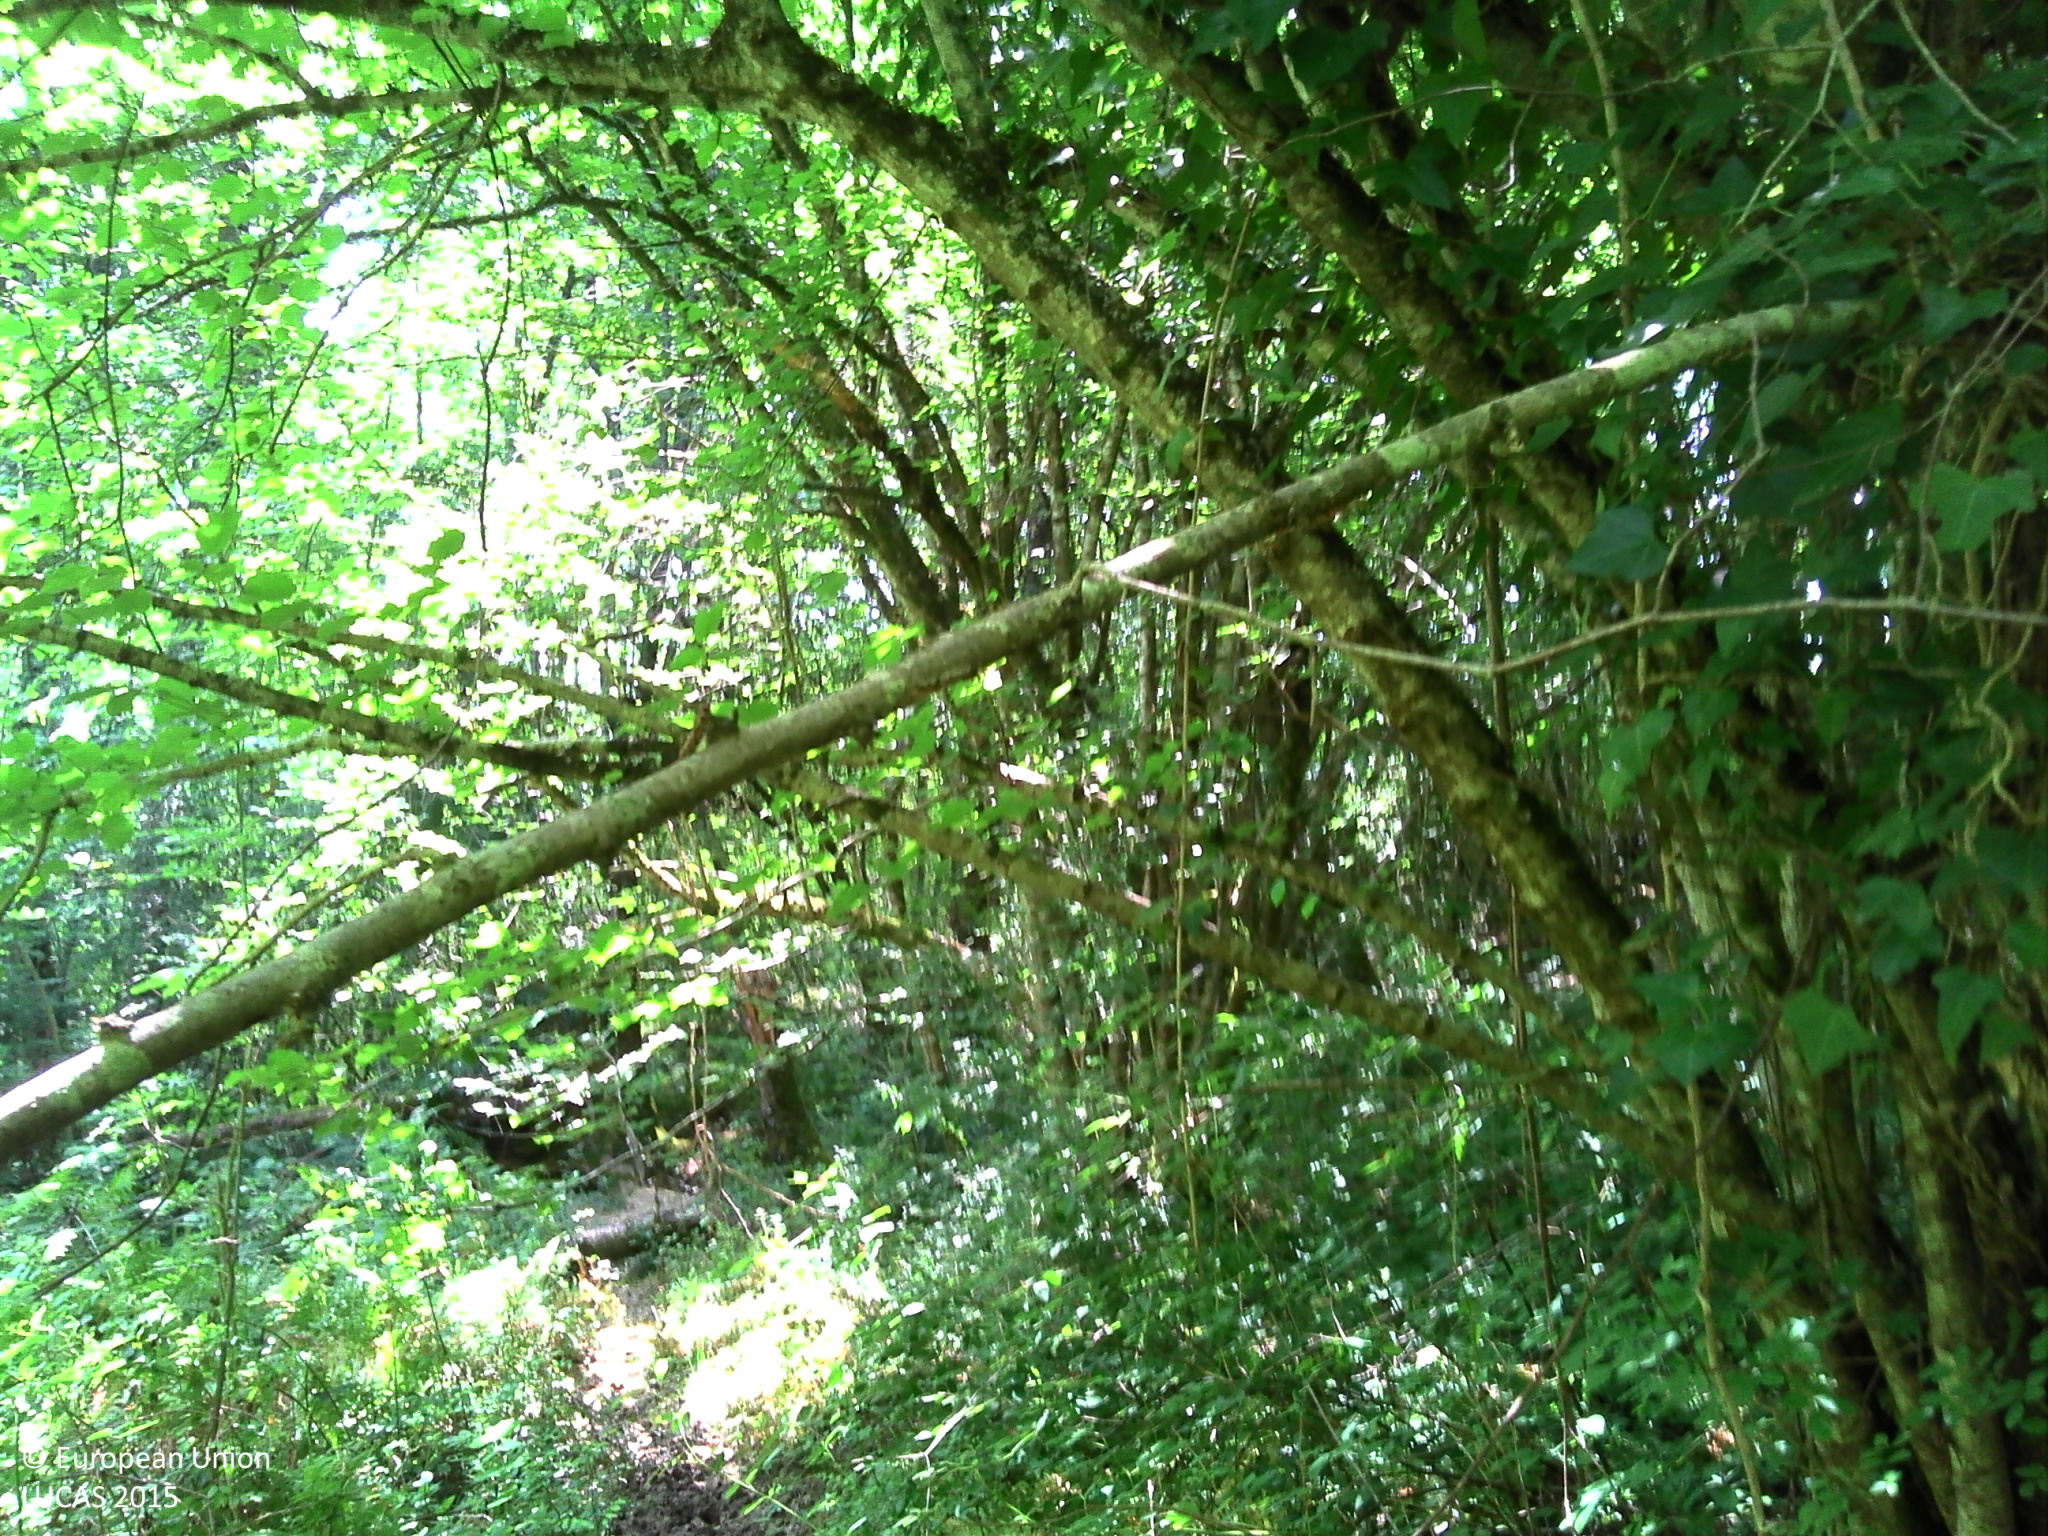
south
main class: Woodland
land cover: Broadleaved woodland
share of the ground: > 75 %
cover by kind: broadleaved forest trees 50 %, shrubs 40 %, herbaceous plants 10 %
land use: Agriculture (excluding fallow land and kitchen gardens)
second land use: Forestry
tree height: > 5 m
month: July
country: FR
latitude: 43.0541
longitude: 1.0289
